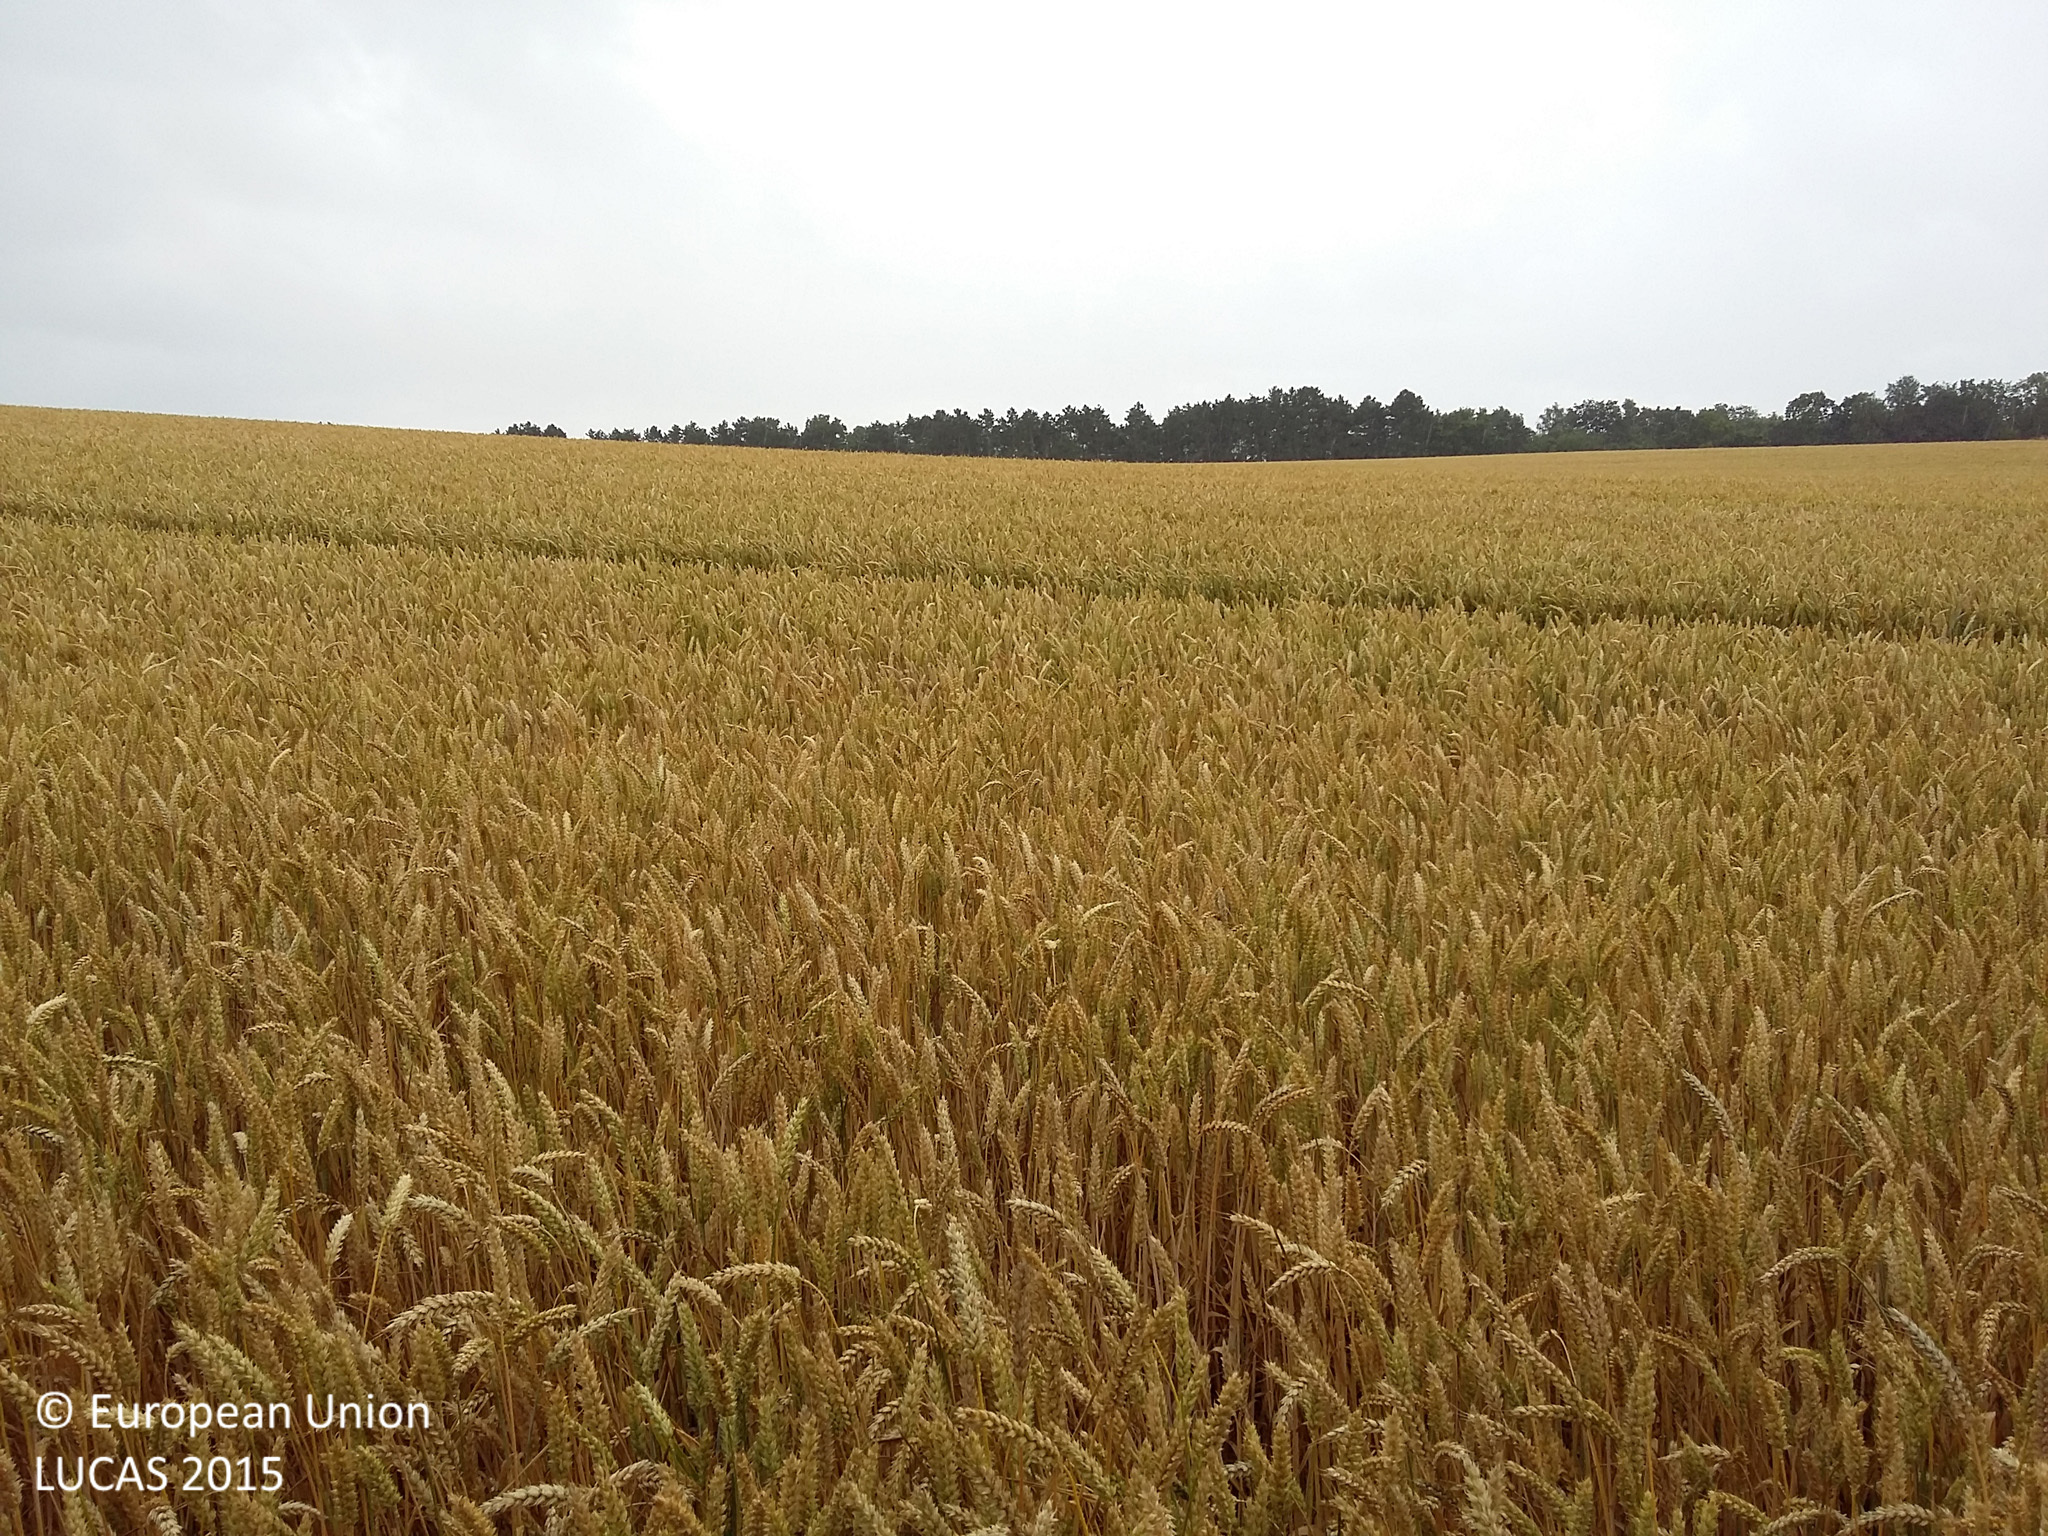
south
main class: Cropland
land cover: Common wheat
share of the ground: > 75 %
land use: Agriculture (excluding fallow land and kitchen gardens)
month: July
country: DK
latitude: 55.8291
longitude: 12.0894
